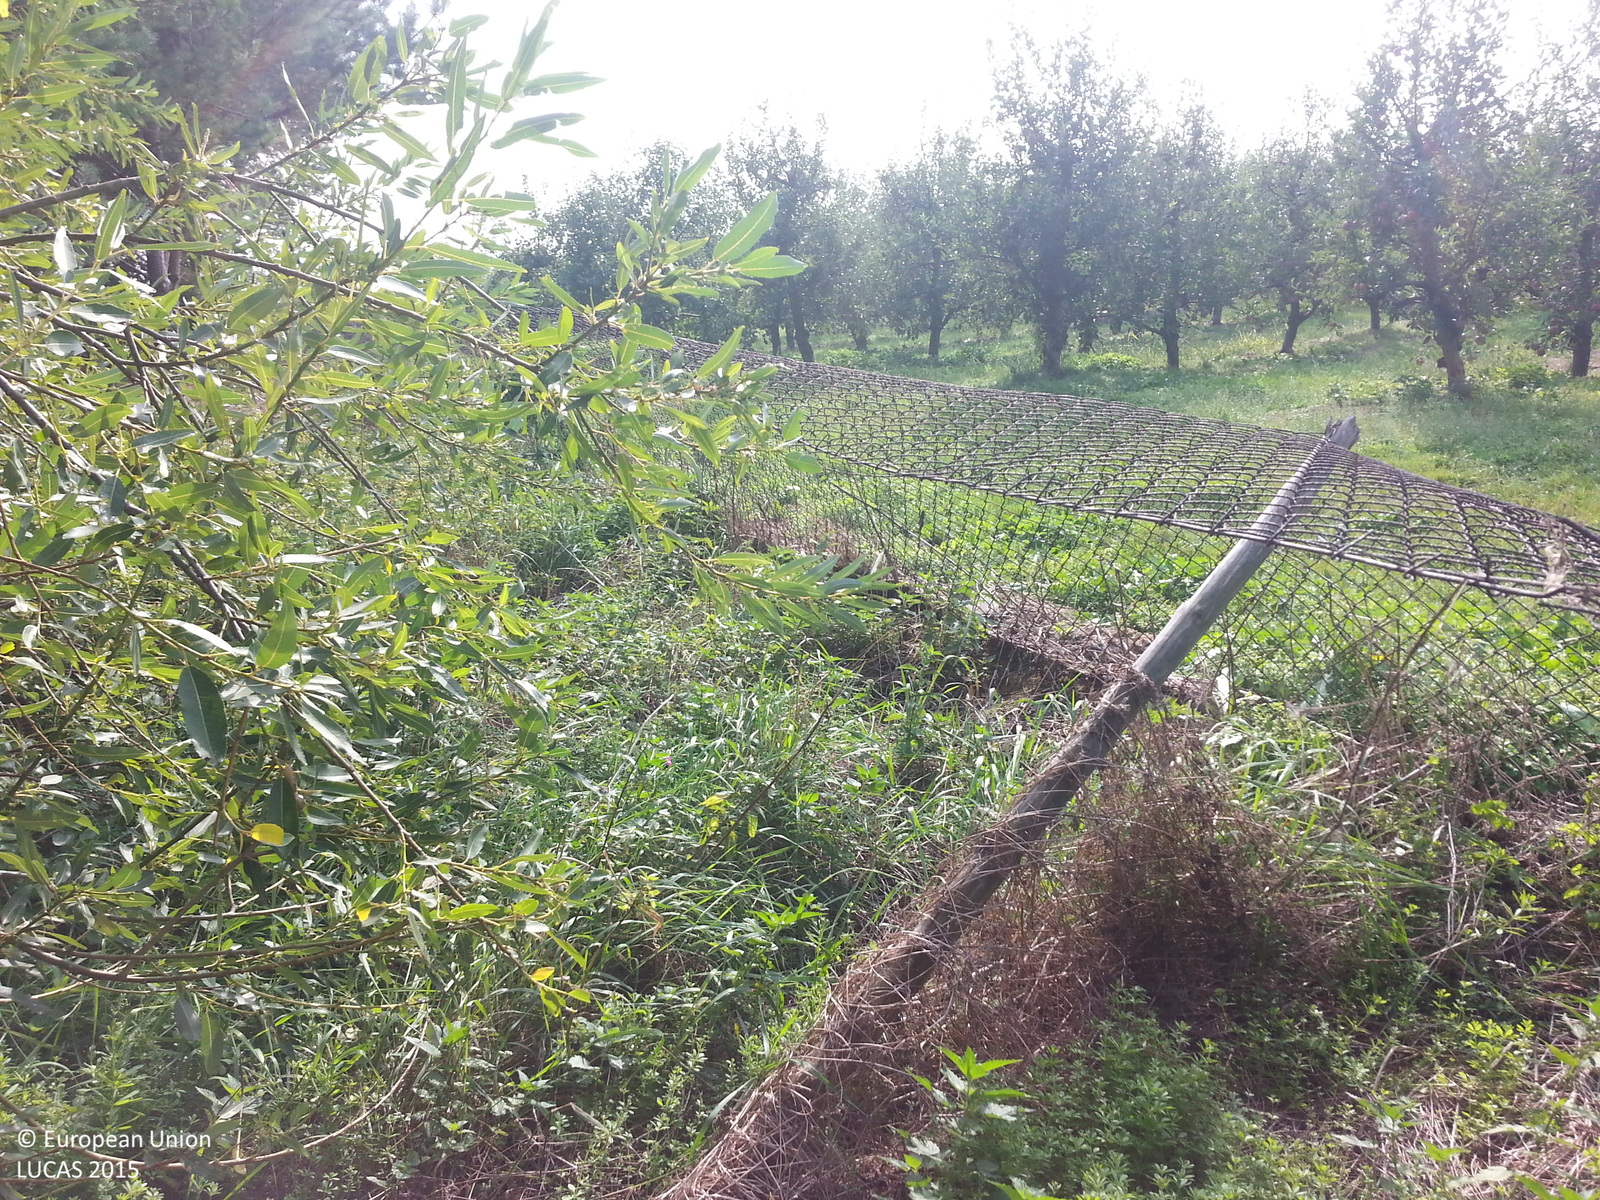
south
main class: Cropland
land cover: Apple fruit
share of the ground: 50 - 75 %
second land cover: Grassland without tree/shrub cover
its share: 50 - 75 %
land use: Agriculture (excluding fallow land and kitchen gardens)
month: September
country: PL
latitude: 52.8963
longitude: 18.0875
